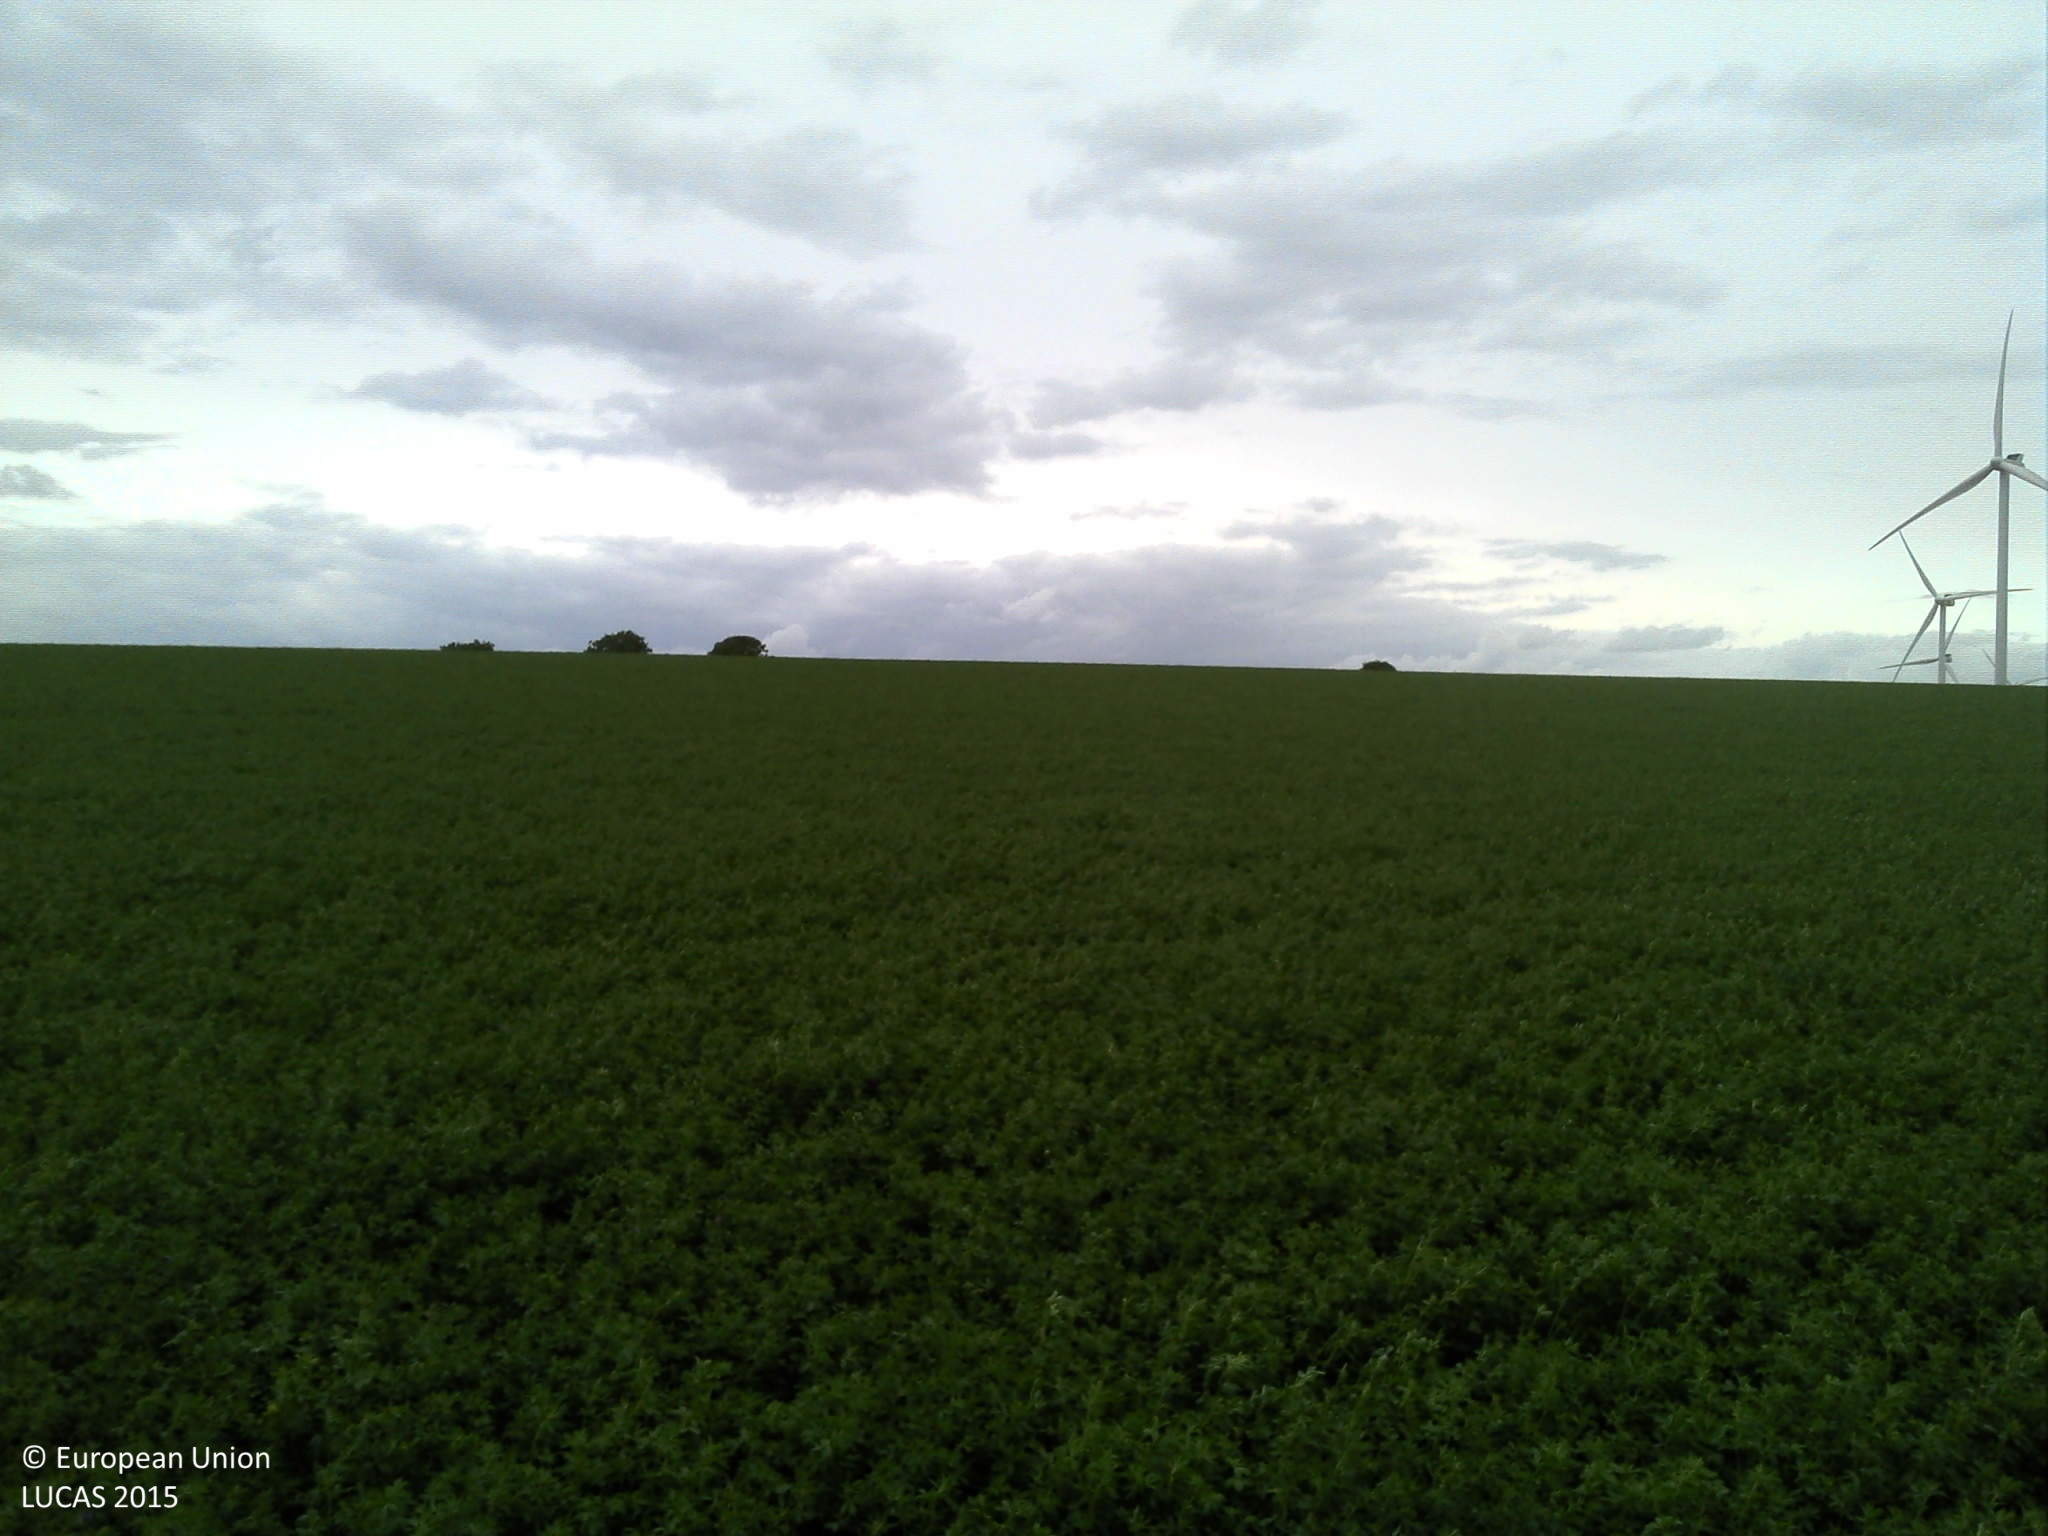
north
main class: Cropland
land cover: Lucerne
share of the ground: > 75 %
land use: Agriculture (excluding fallow land and kitchen gardens)
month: July
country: FR
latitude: 49.5443
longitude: 4.0936
